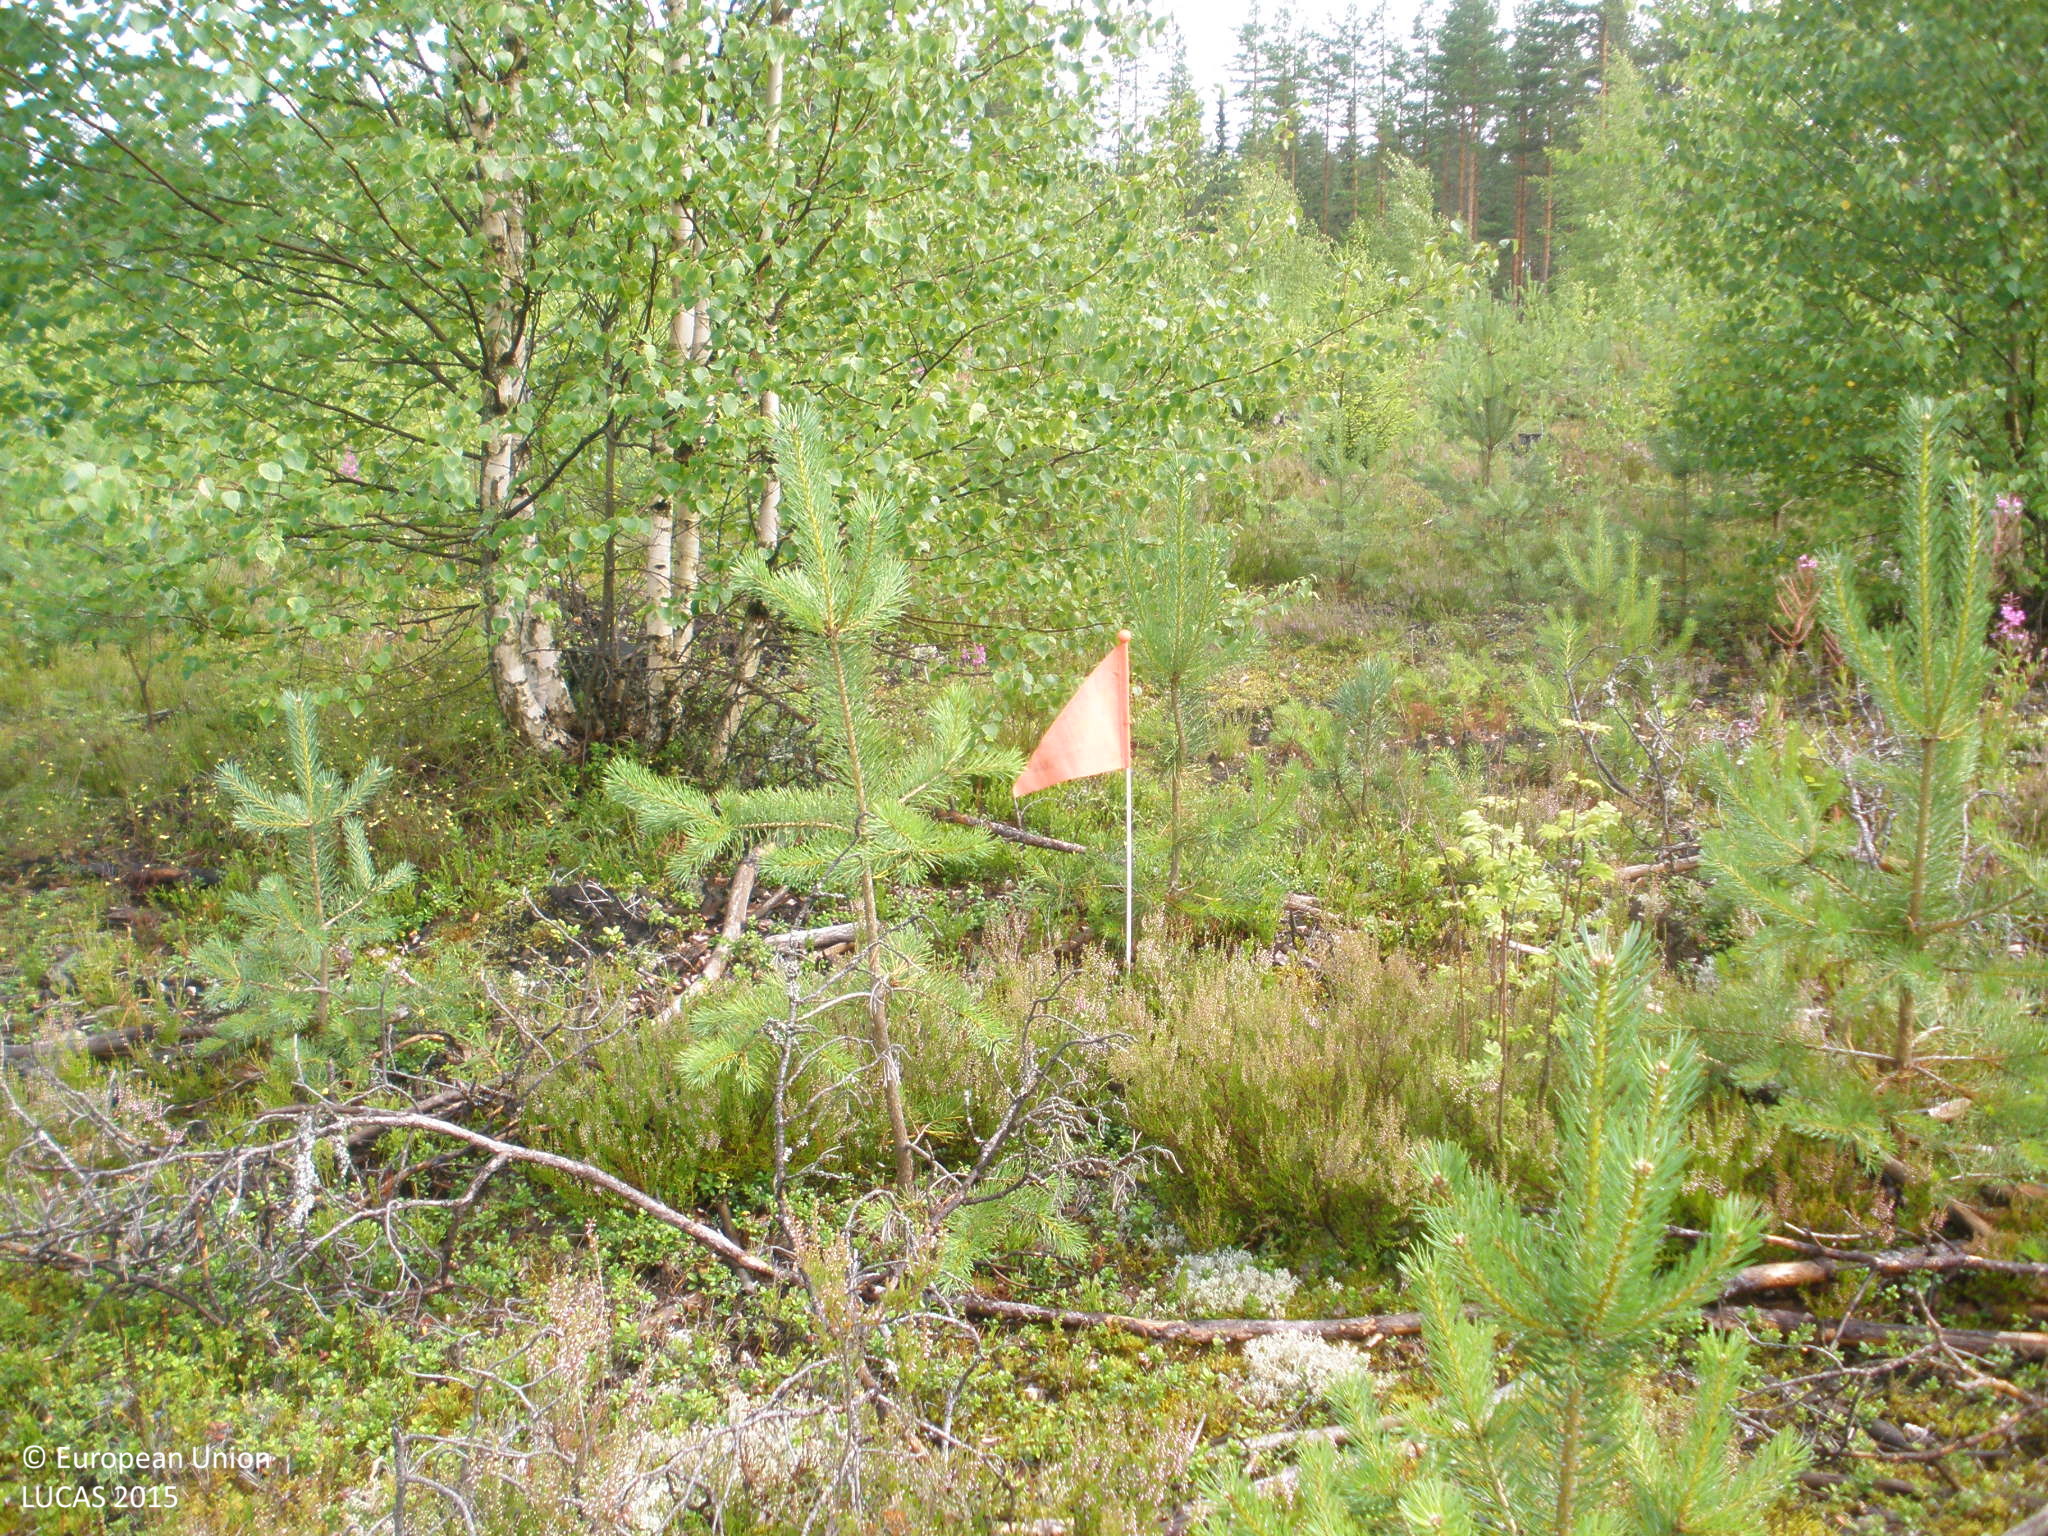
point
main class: Woodland
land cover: Pine dominated mixed woodland
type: boreal forest
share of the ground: 25 - 50 %
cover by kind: lichens and mosses 30 %, broadleaved forest trees 25 %, coniferous forest trees 20 %, shrubs 10 %, herbaceous plants 10 %, unconsolidated bare surface 5 %
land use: Forestry
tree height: < 5 m
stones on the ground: 10 - 25 %
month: July
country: FI
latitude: 61.2208
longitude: 24.7224
